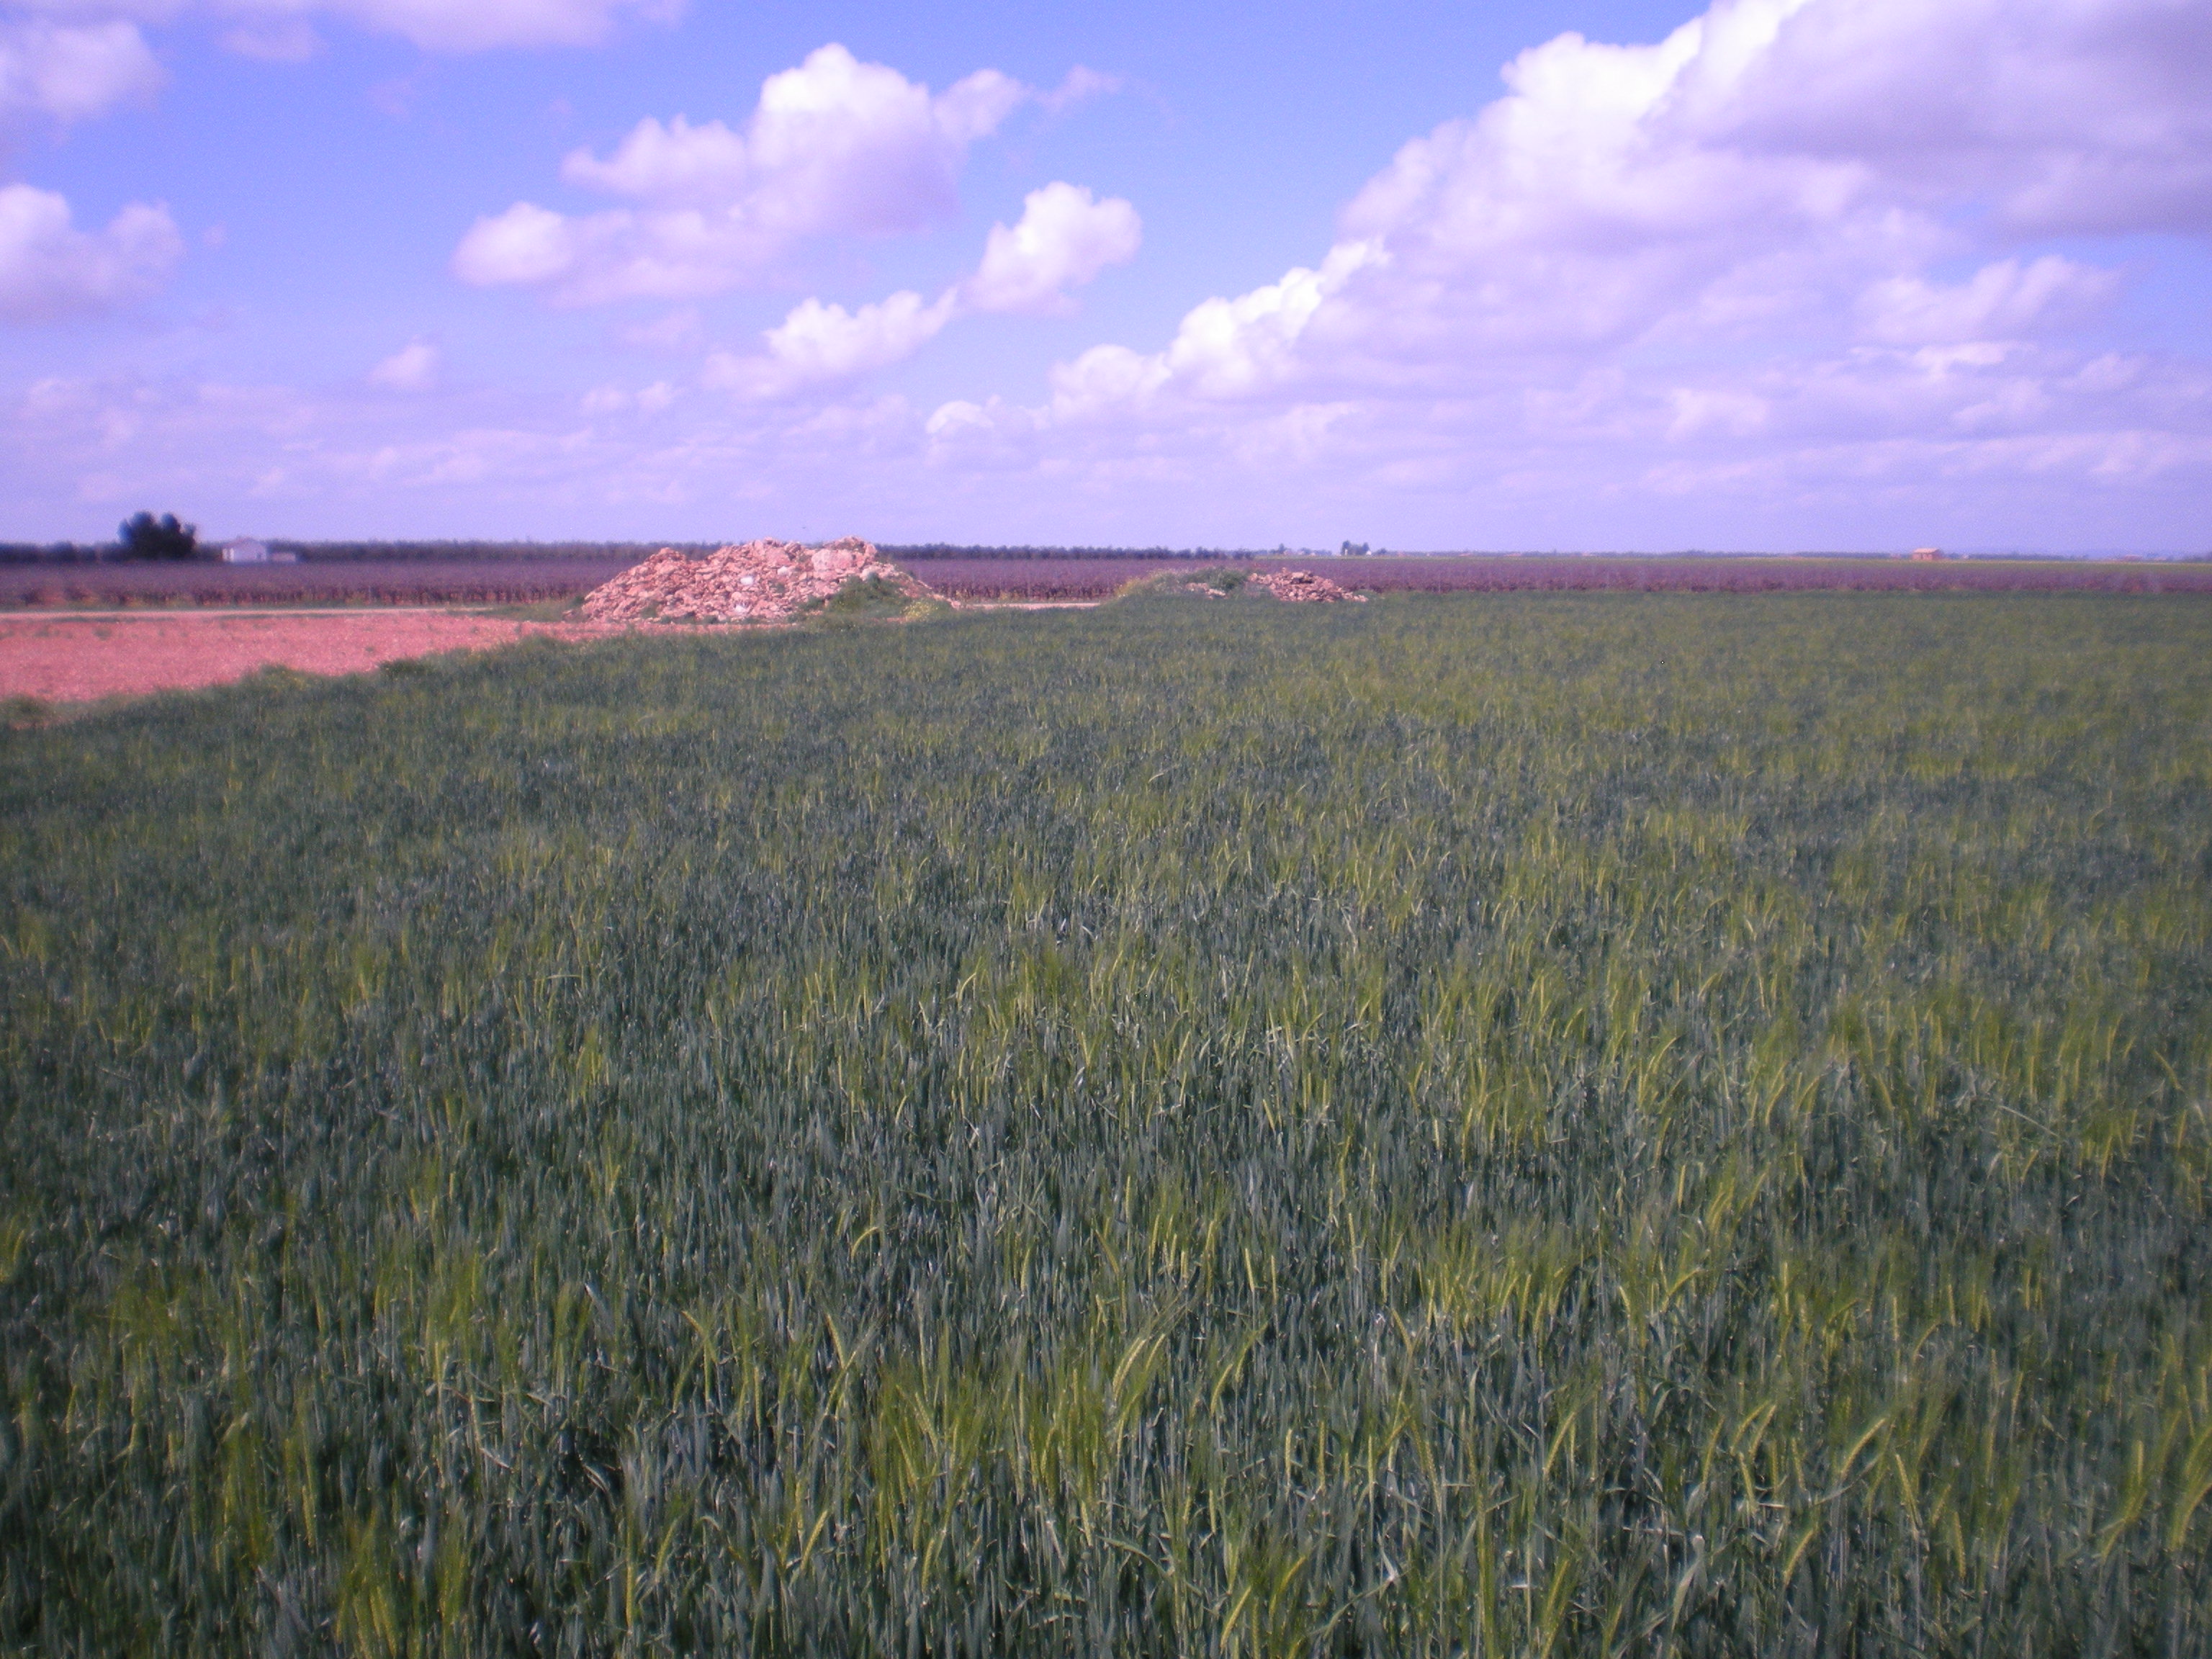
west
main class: Cropland
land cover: Barley
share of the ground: > 75 %
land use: Agriculture (excluding fallow land and kitchen gardens)
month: April
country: ES
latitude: 38.9736
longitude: -3.5551
